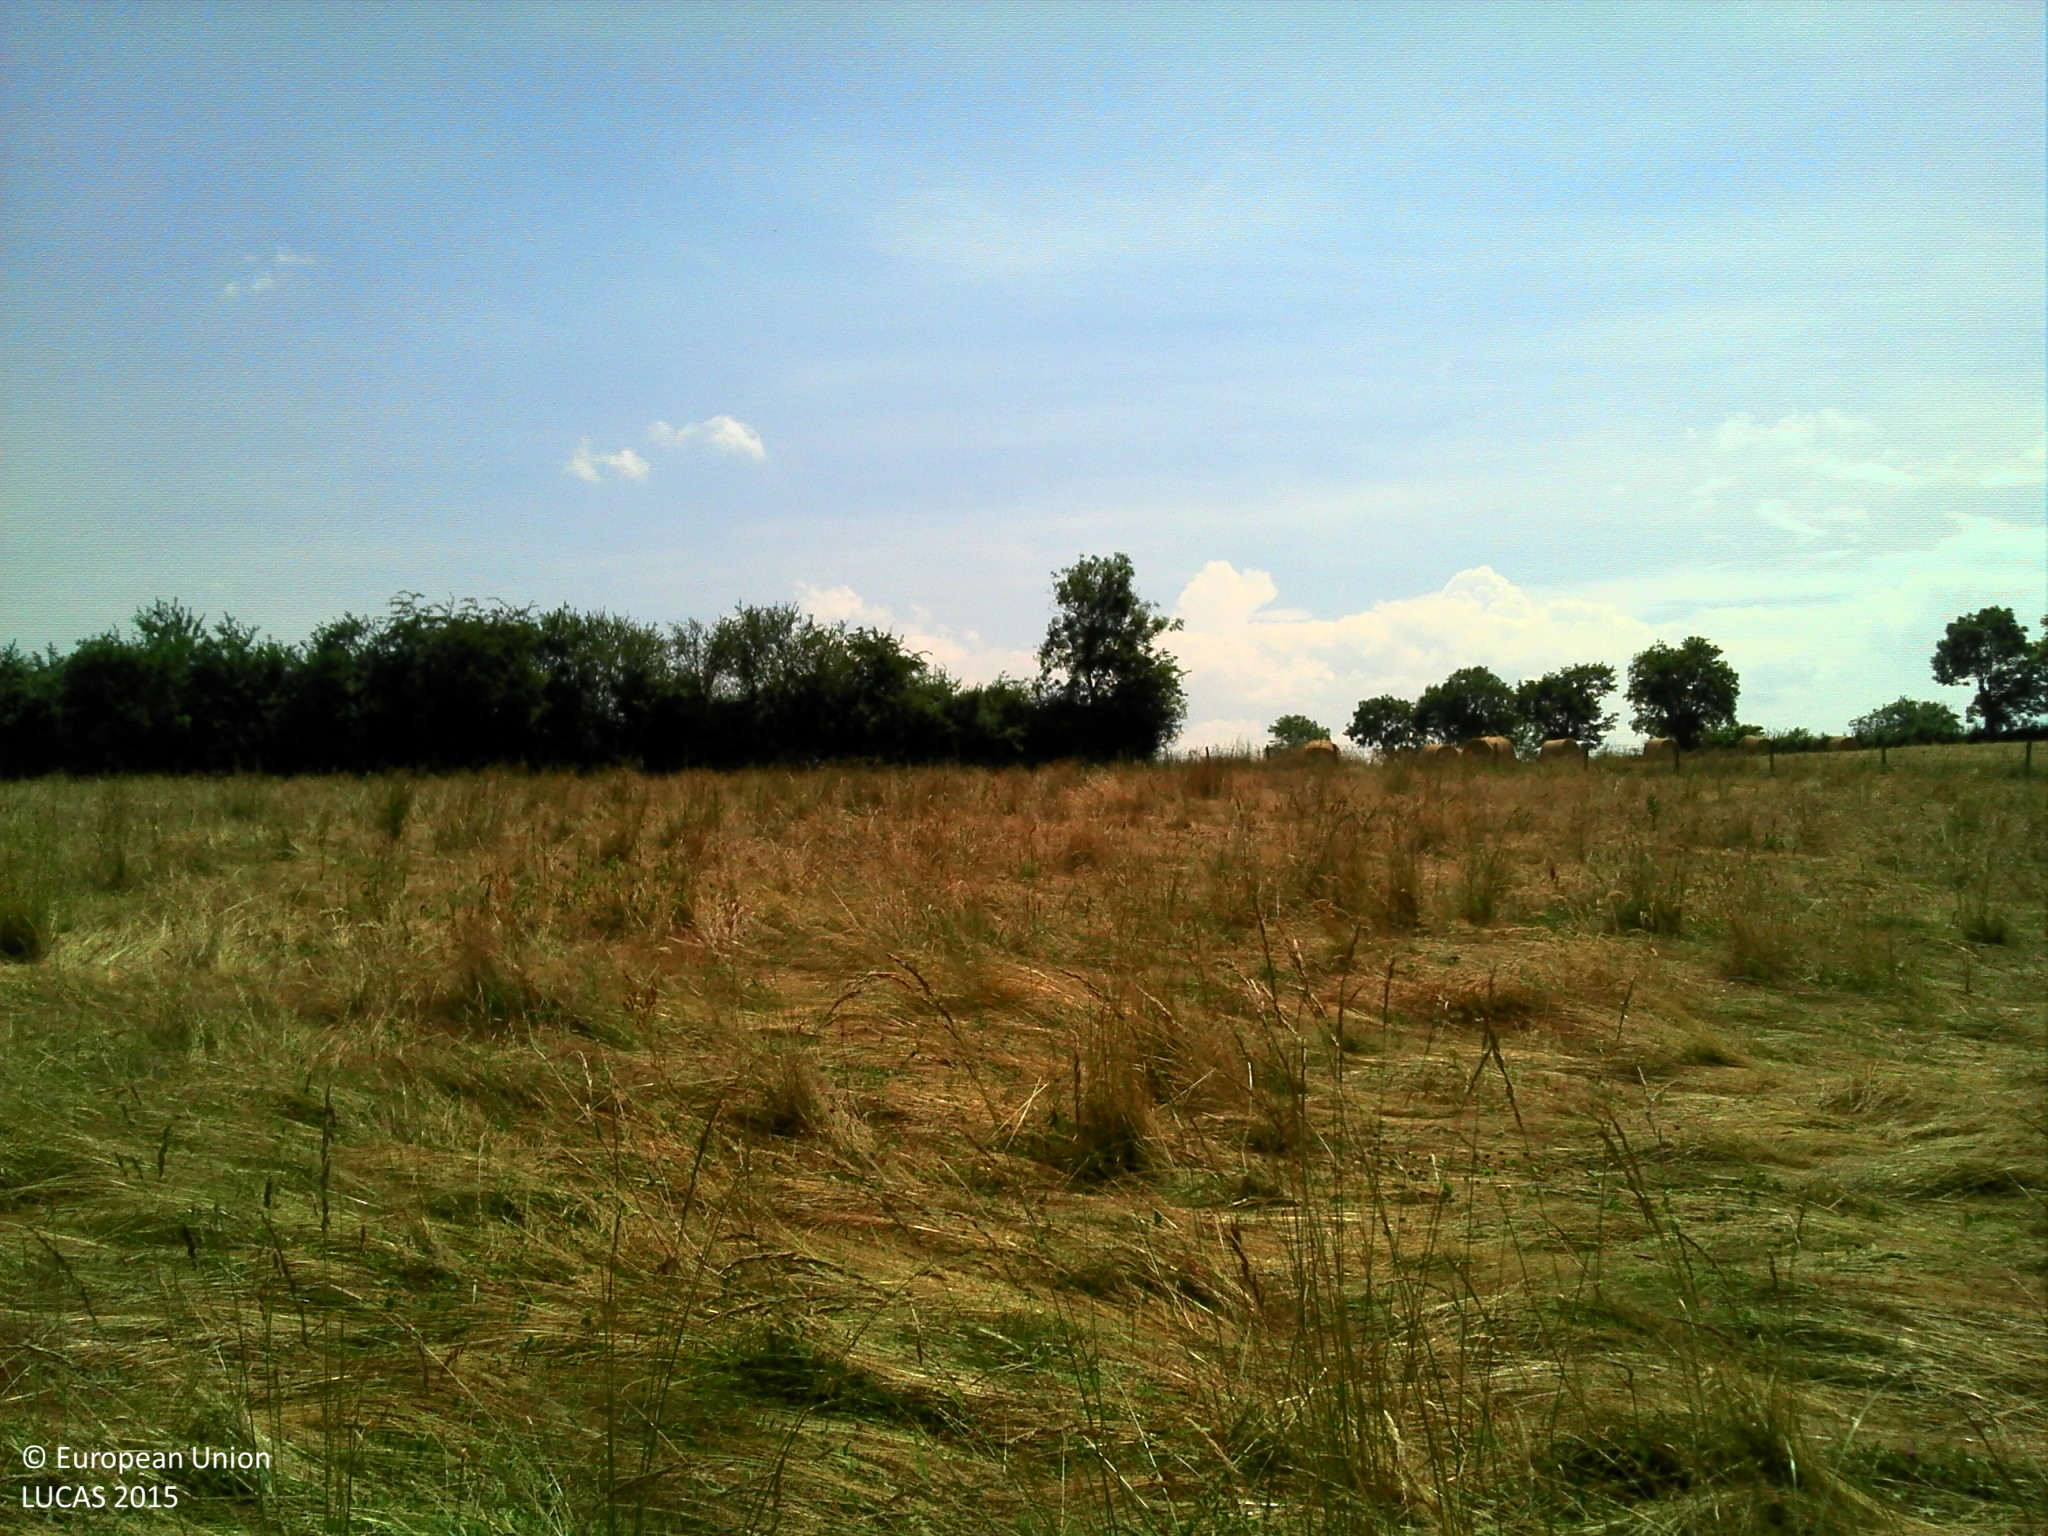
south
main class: Grassland
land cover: Grassland without tree/shrub cover
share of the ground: > 75 %
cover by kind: herbaceous plants 100 %
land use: Agriculture (excluding fallow land and kitchen gardens)
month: June
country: FR
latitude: 46.3400
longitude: 3.0209
